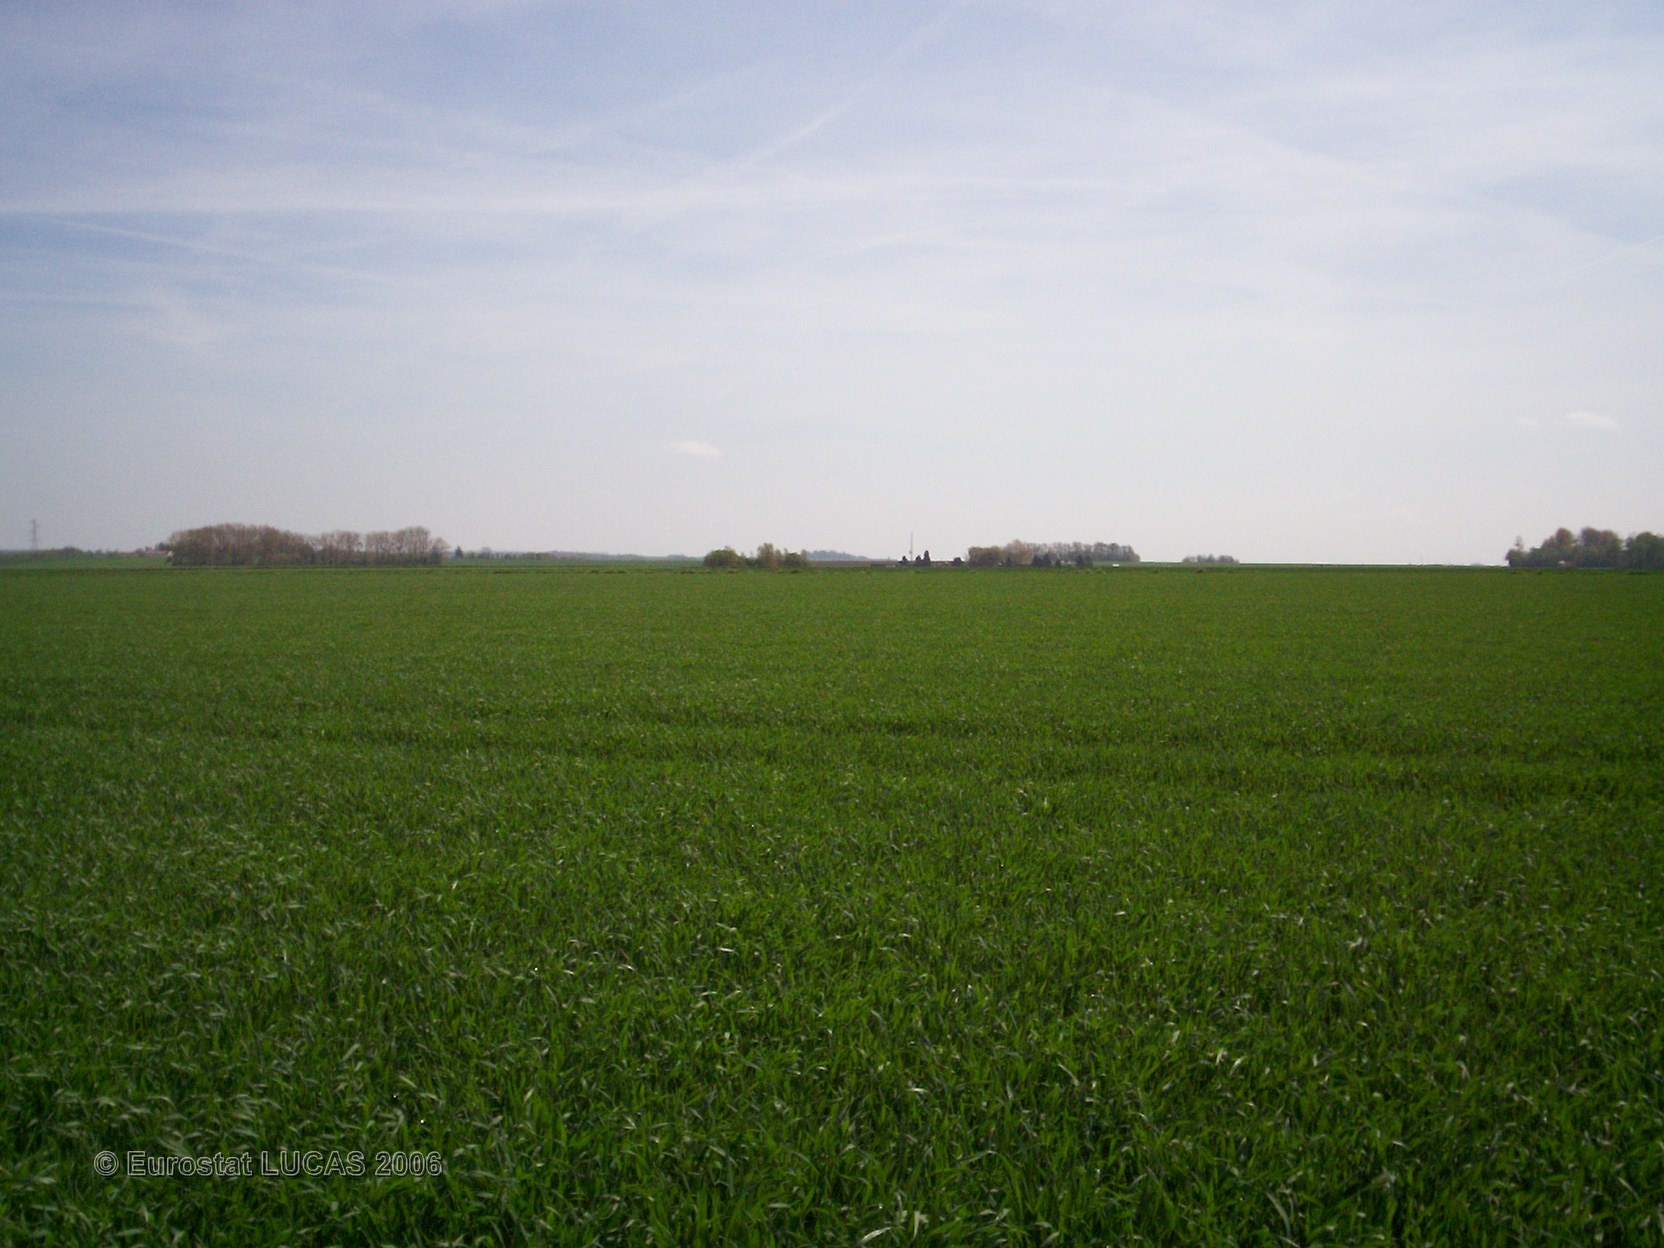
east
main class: Cropland
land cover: Common wheat
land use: Agriculture (excluding fallow land and kitchen gardens)
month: May
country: FR
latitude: 48.8411
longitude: 2.8645
